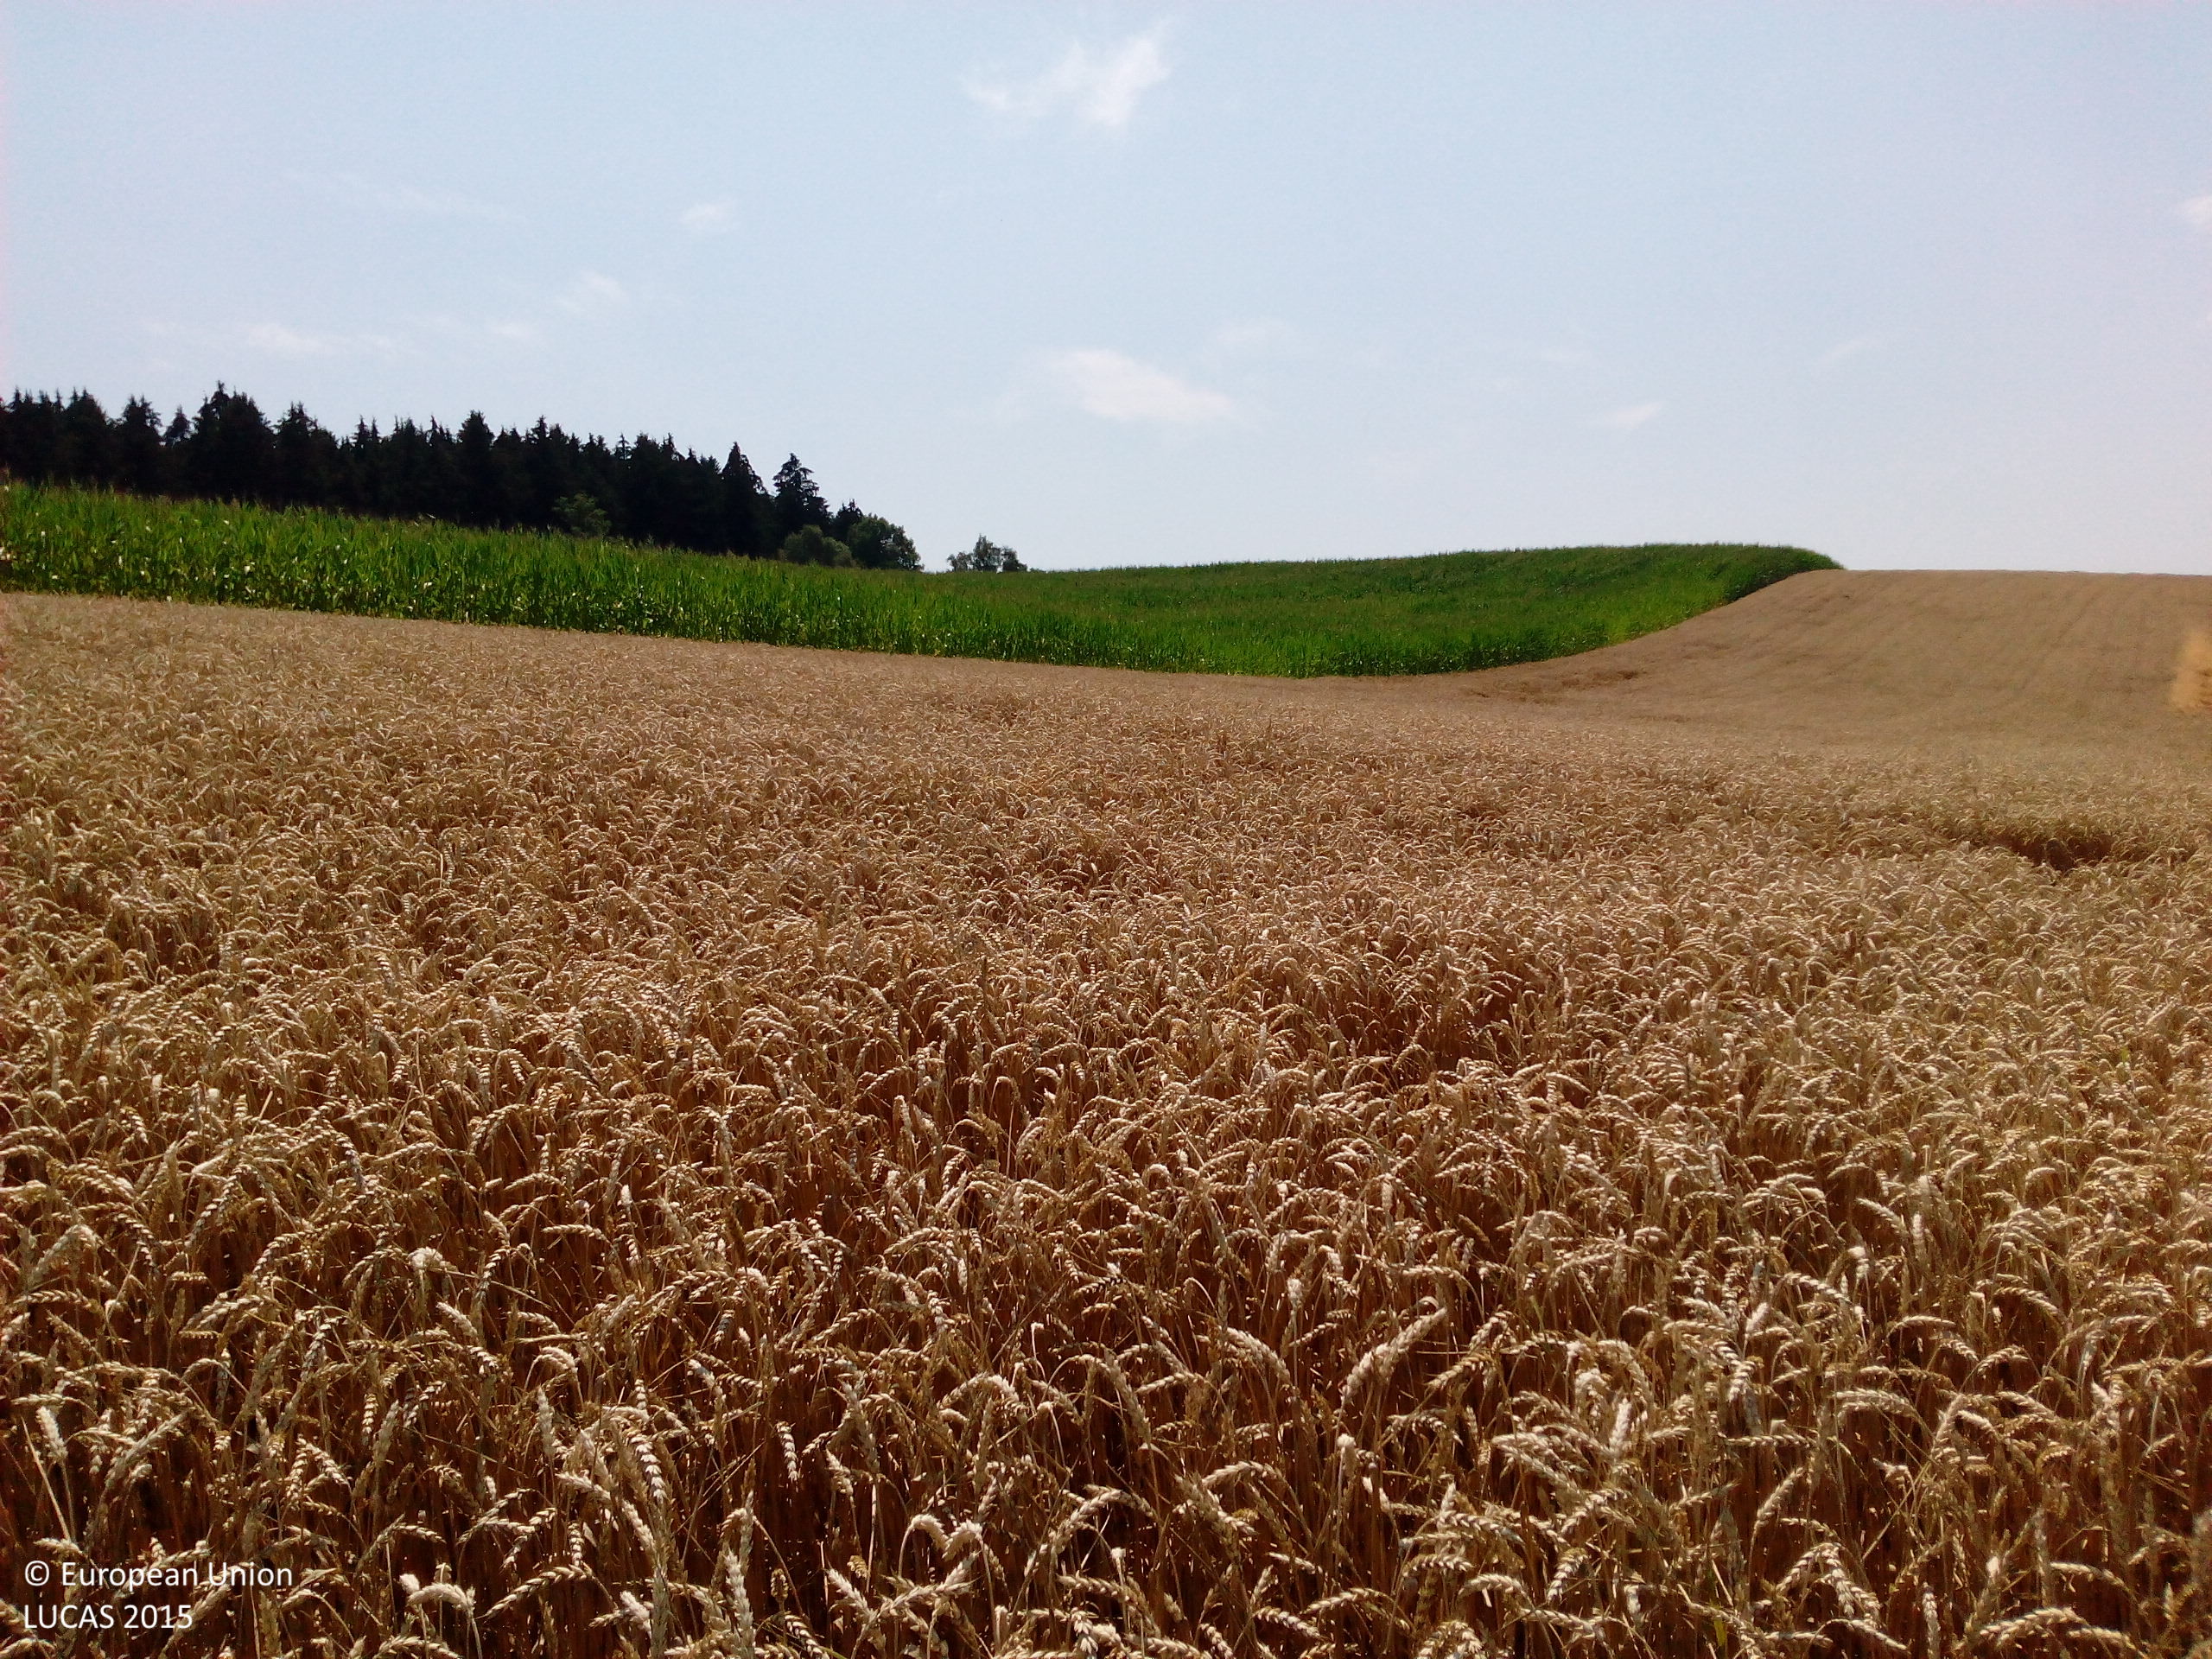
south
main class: Cropland
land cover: Maize
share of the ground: > 75 %
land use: Agriculture (excluding fallow land and kitchen gardens)
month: July
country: DE
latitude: 48.4546
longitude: 12.9334
